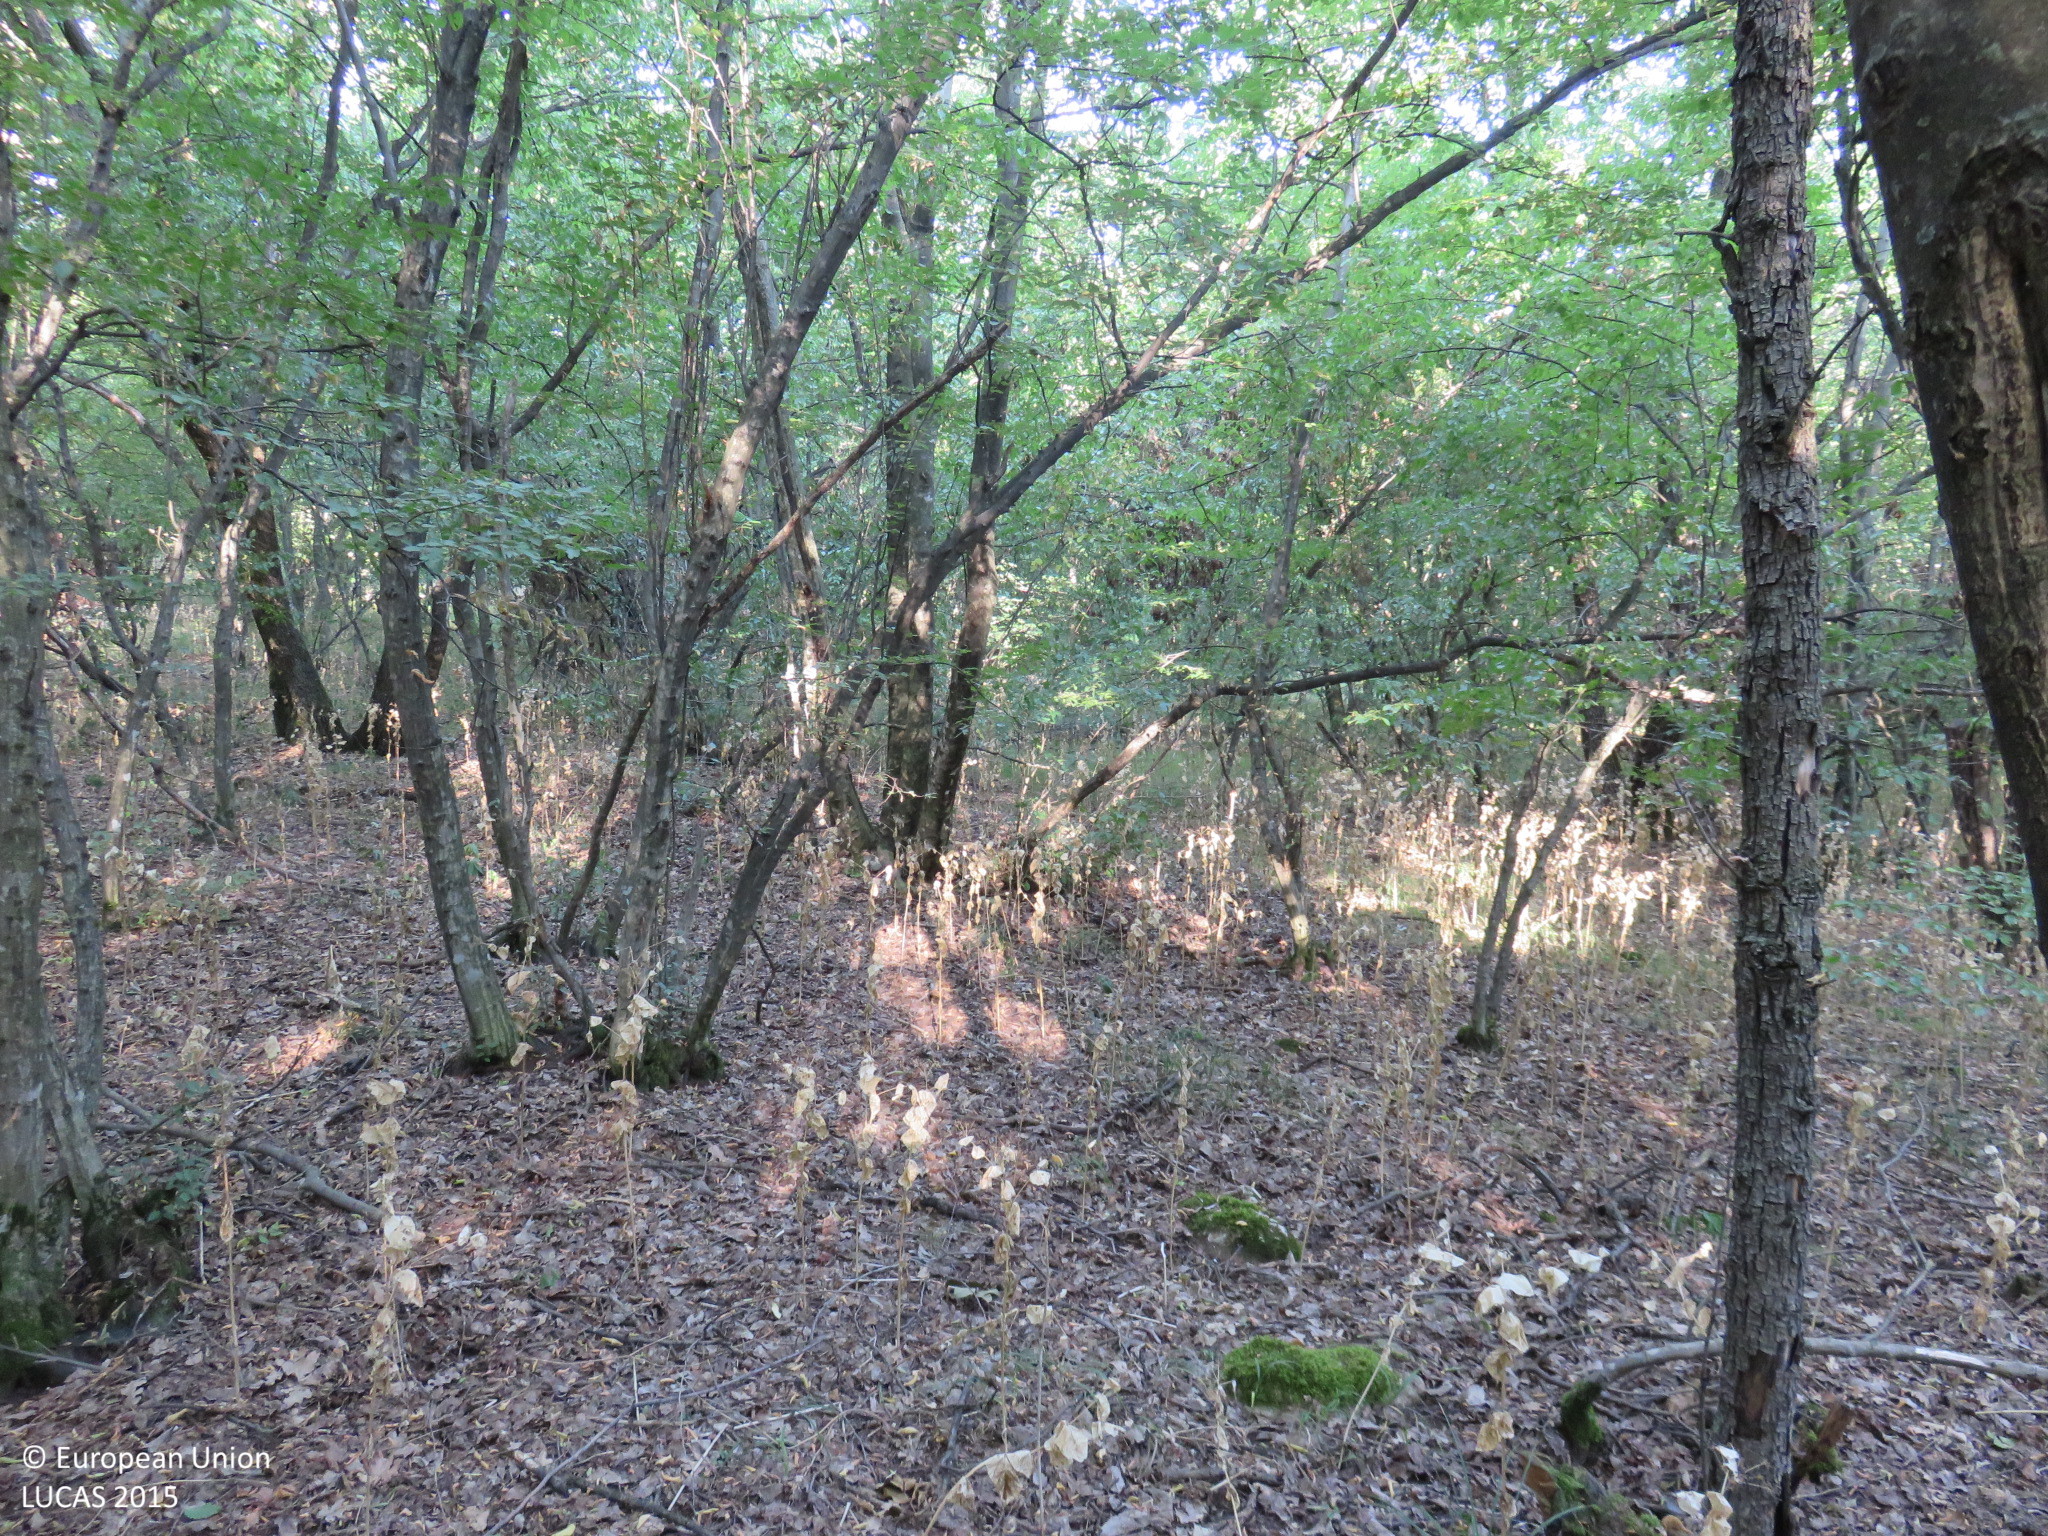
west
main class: Woodland
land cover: Broadleaved woodland
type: mesophytic deciduous forest
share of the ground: > 75 %
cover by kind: broadleaved forest trees 90 %, unconsolidated bare surface 10 %
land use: Forestry
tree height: < 5 m
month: July
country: BG
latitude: 43.2267
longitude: 25.0532
